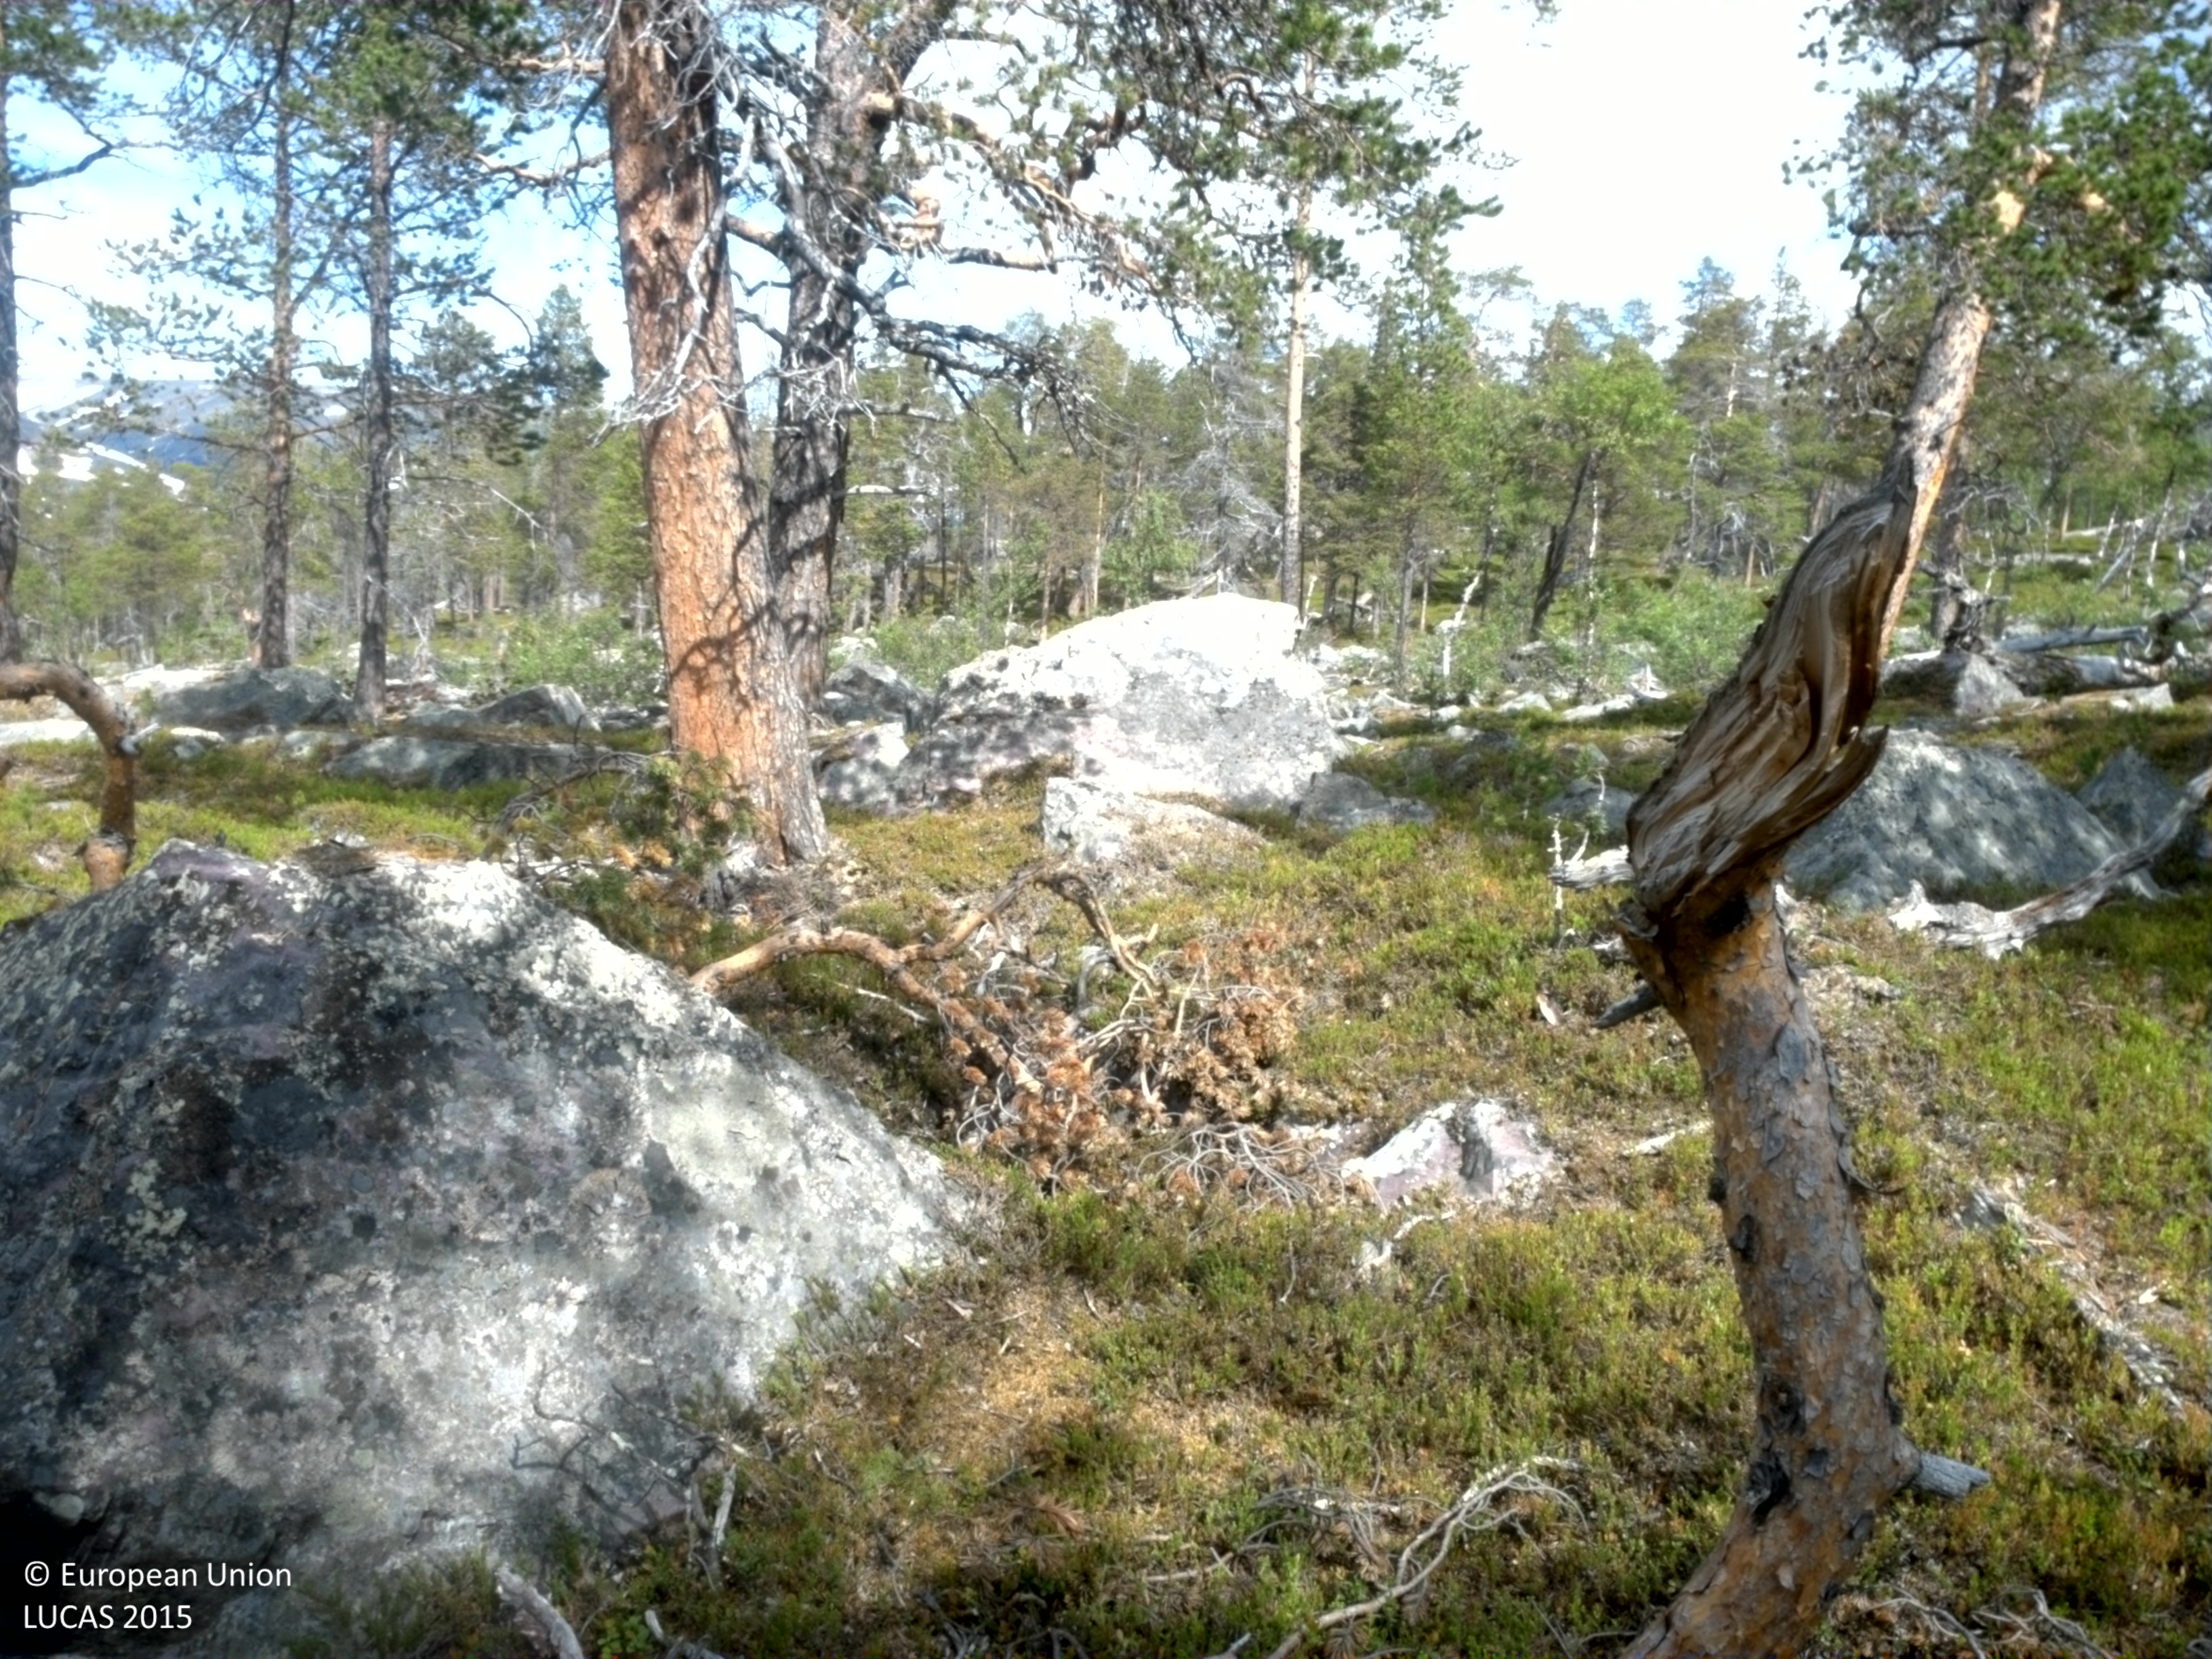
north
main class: Woodland
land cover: Pine dominated coniferous woodland
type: boreal forest
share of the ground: 10 - 25 %
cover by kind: shrubs 60 %, coniferous forest trees 20 %, consolidated bare surface 15 %, broadleaved forest trees 5 %
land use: Forestry
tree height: > 5 m
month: July
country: SE
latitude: 67.4714
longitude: 18.3849
